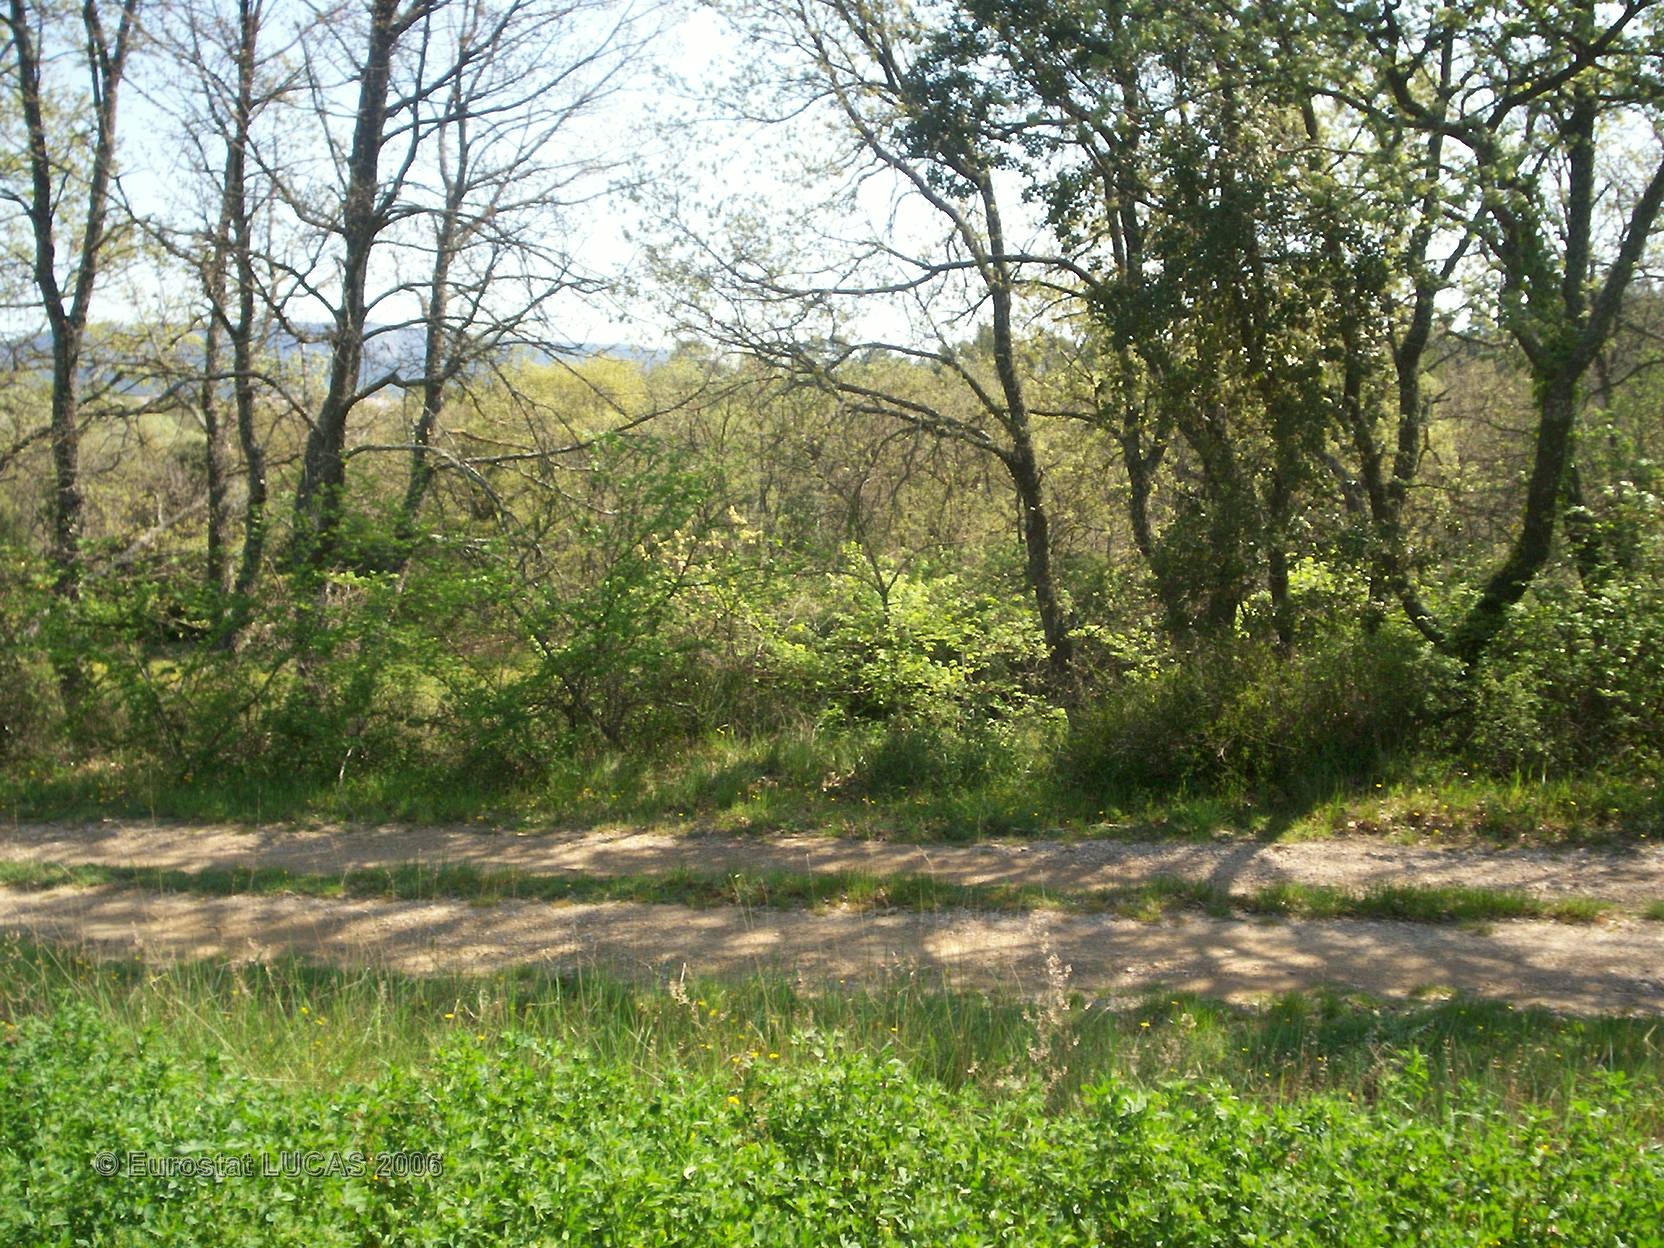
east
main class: Cropland
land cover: Lucerne
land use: Agriculture (excluding fallow land and kitchen gardens)
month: April
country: FR
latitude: 43.6084
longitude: 5.6357
